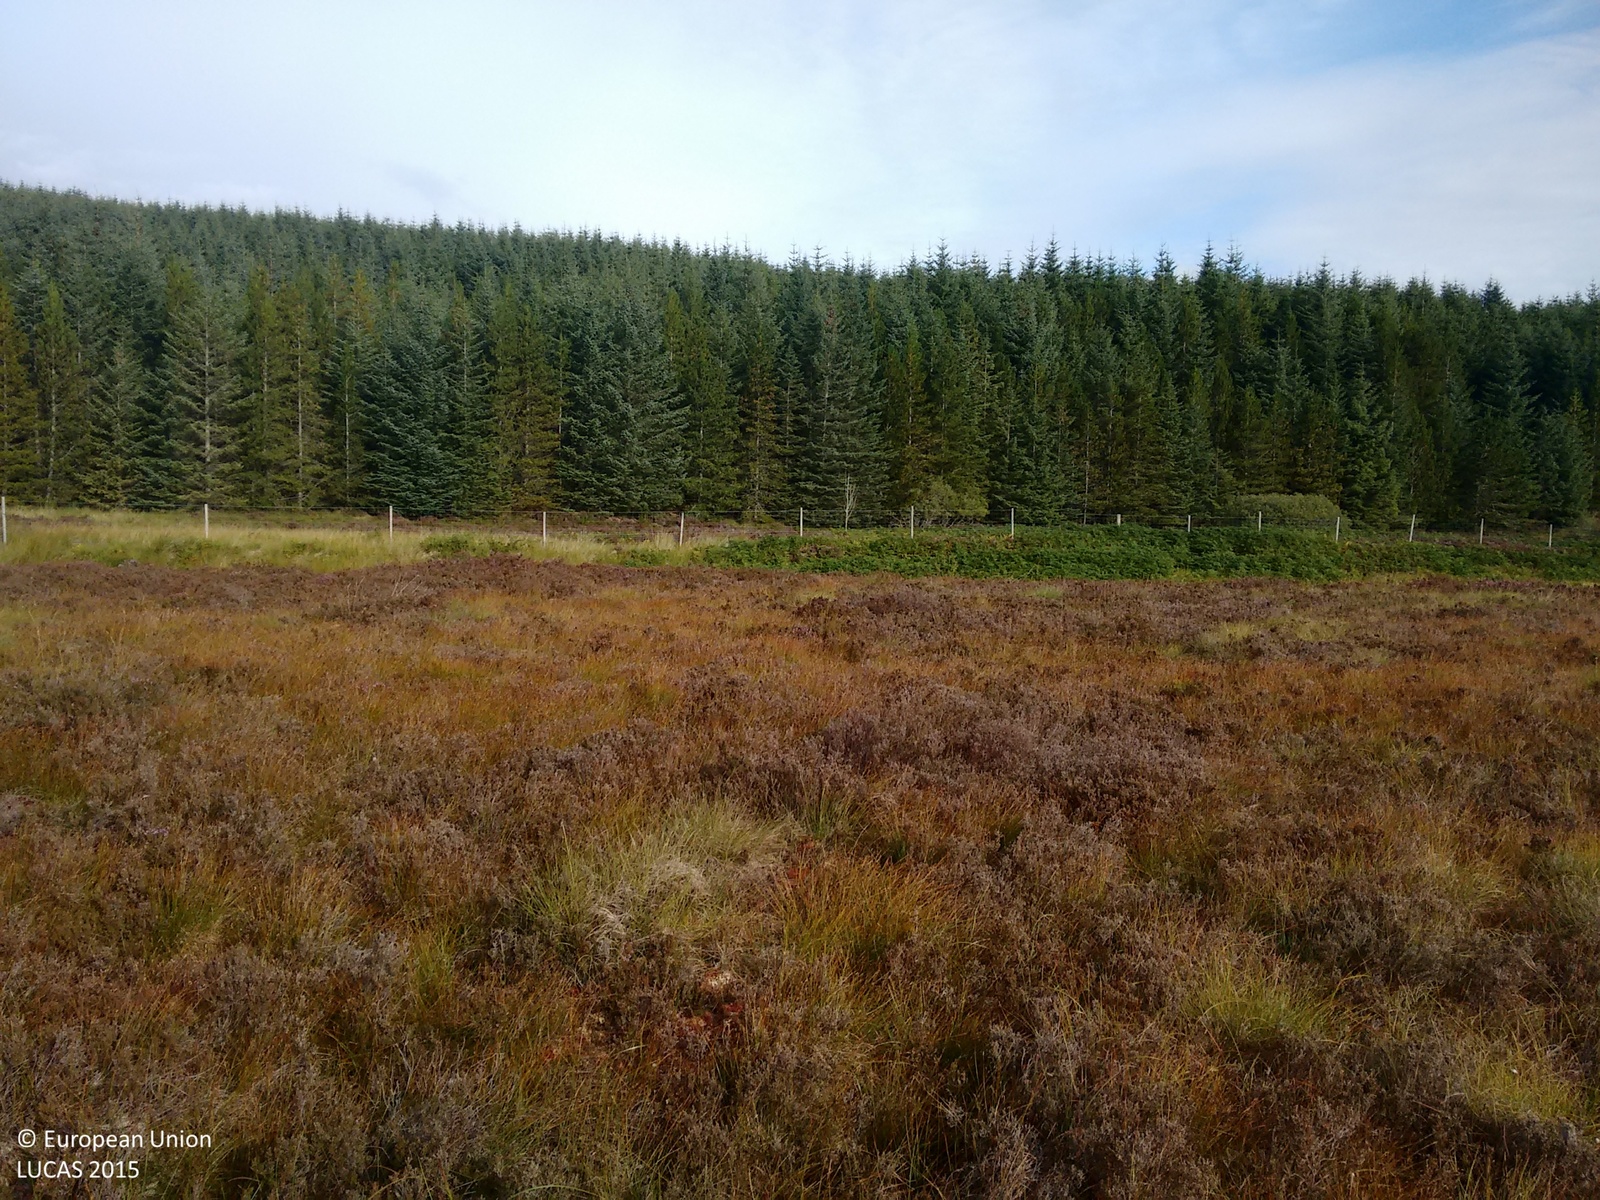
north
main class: Shrubland
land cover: Shrubland without tree cover
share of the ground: > 75 %
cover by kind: shrubs 75 %, herbaceous plants 20 %, lichens and mosses 5 %
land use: Semi-natural and natural areas not in use
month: September
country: GB
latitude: 57.8461
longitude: -4.3553
